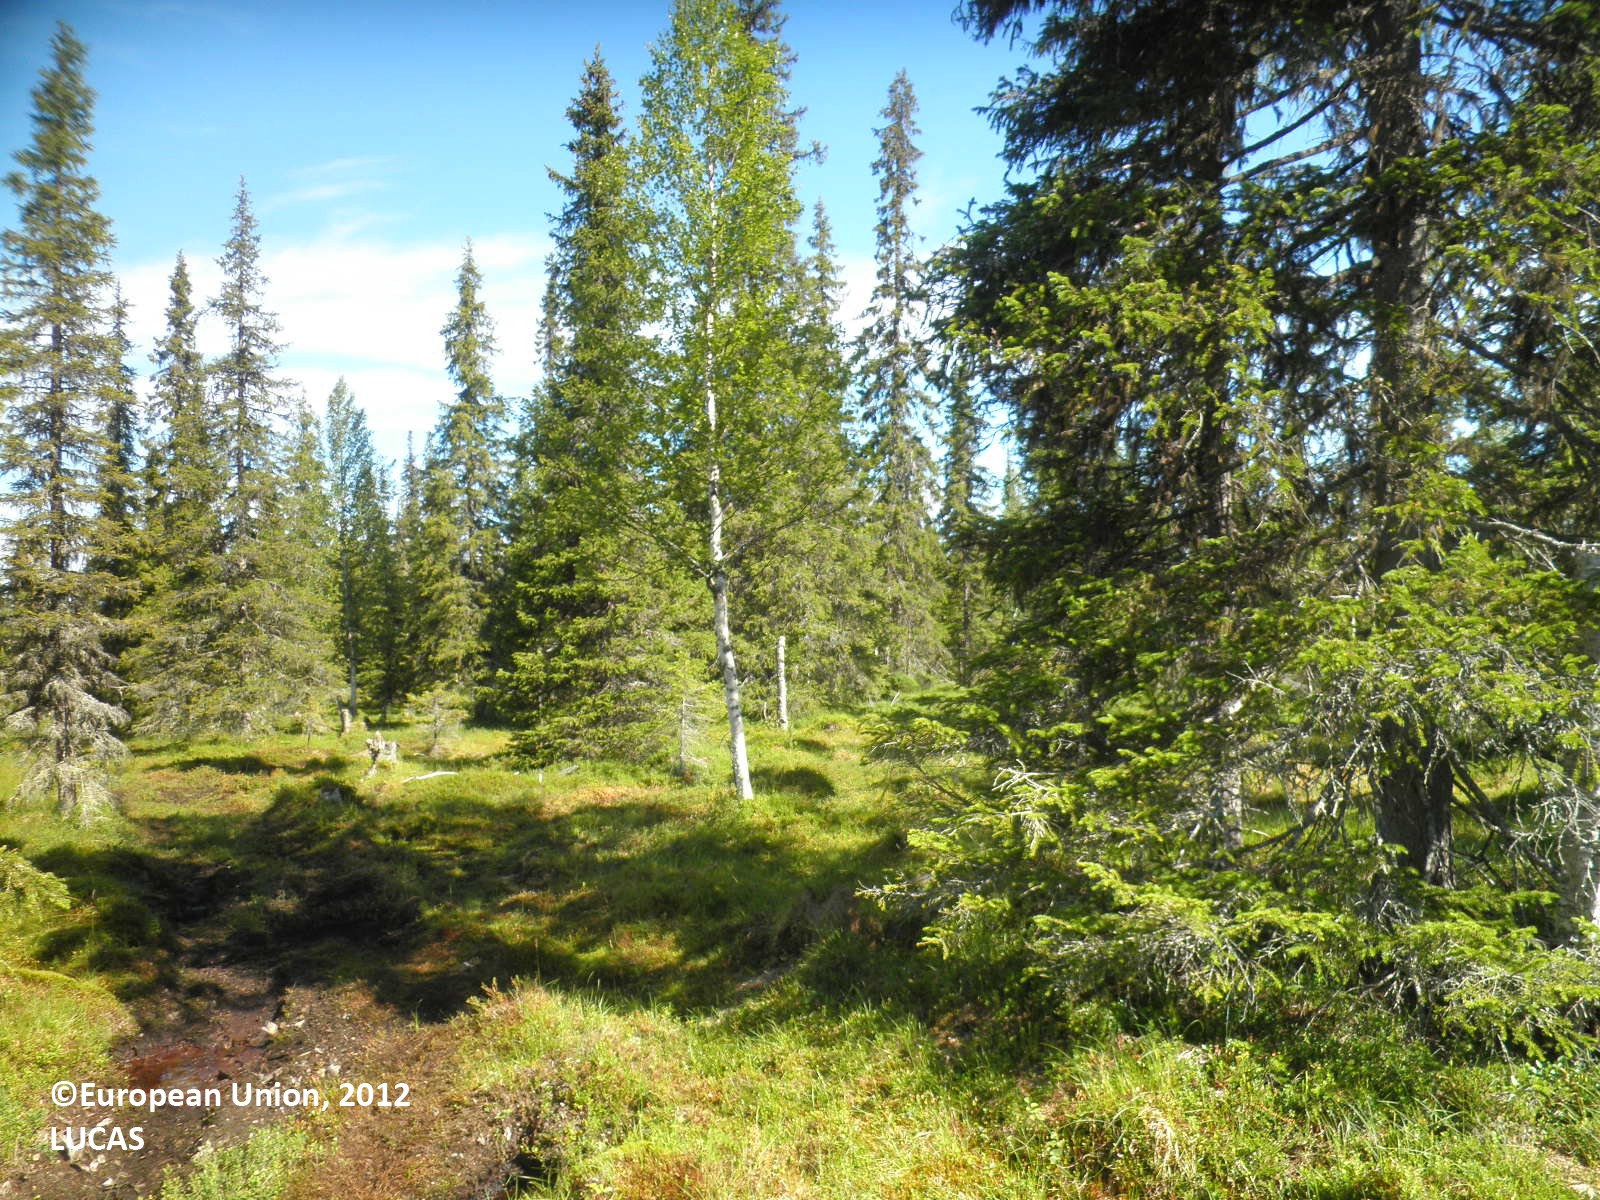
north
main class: Woodland
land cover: Spruce dominated mixed woodland
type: boreal forest
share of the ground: 25 - 50 %
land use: Forestry
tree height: > 5 m
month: July
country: FI
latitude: 67.7126
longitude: 26.2471
